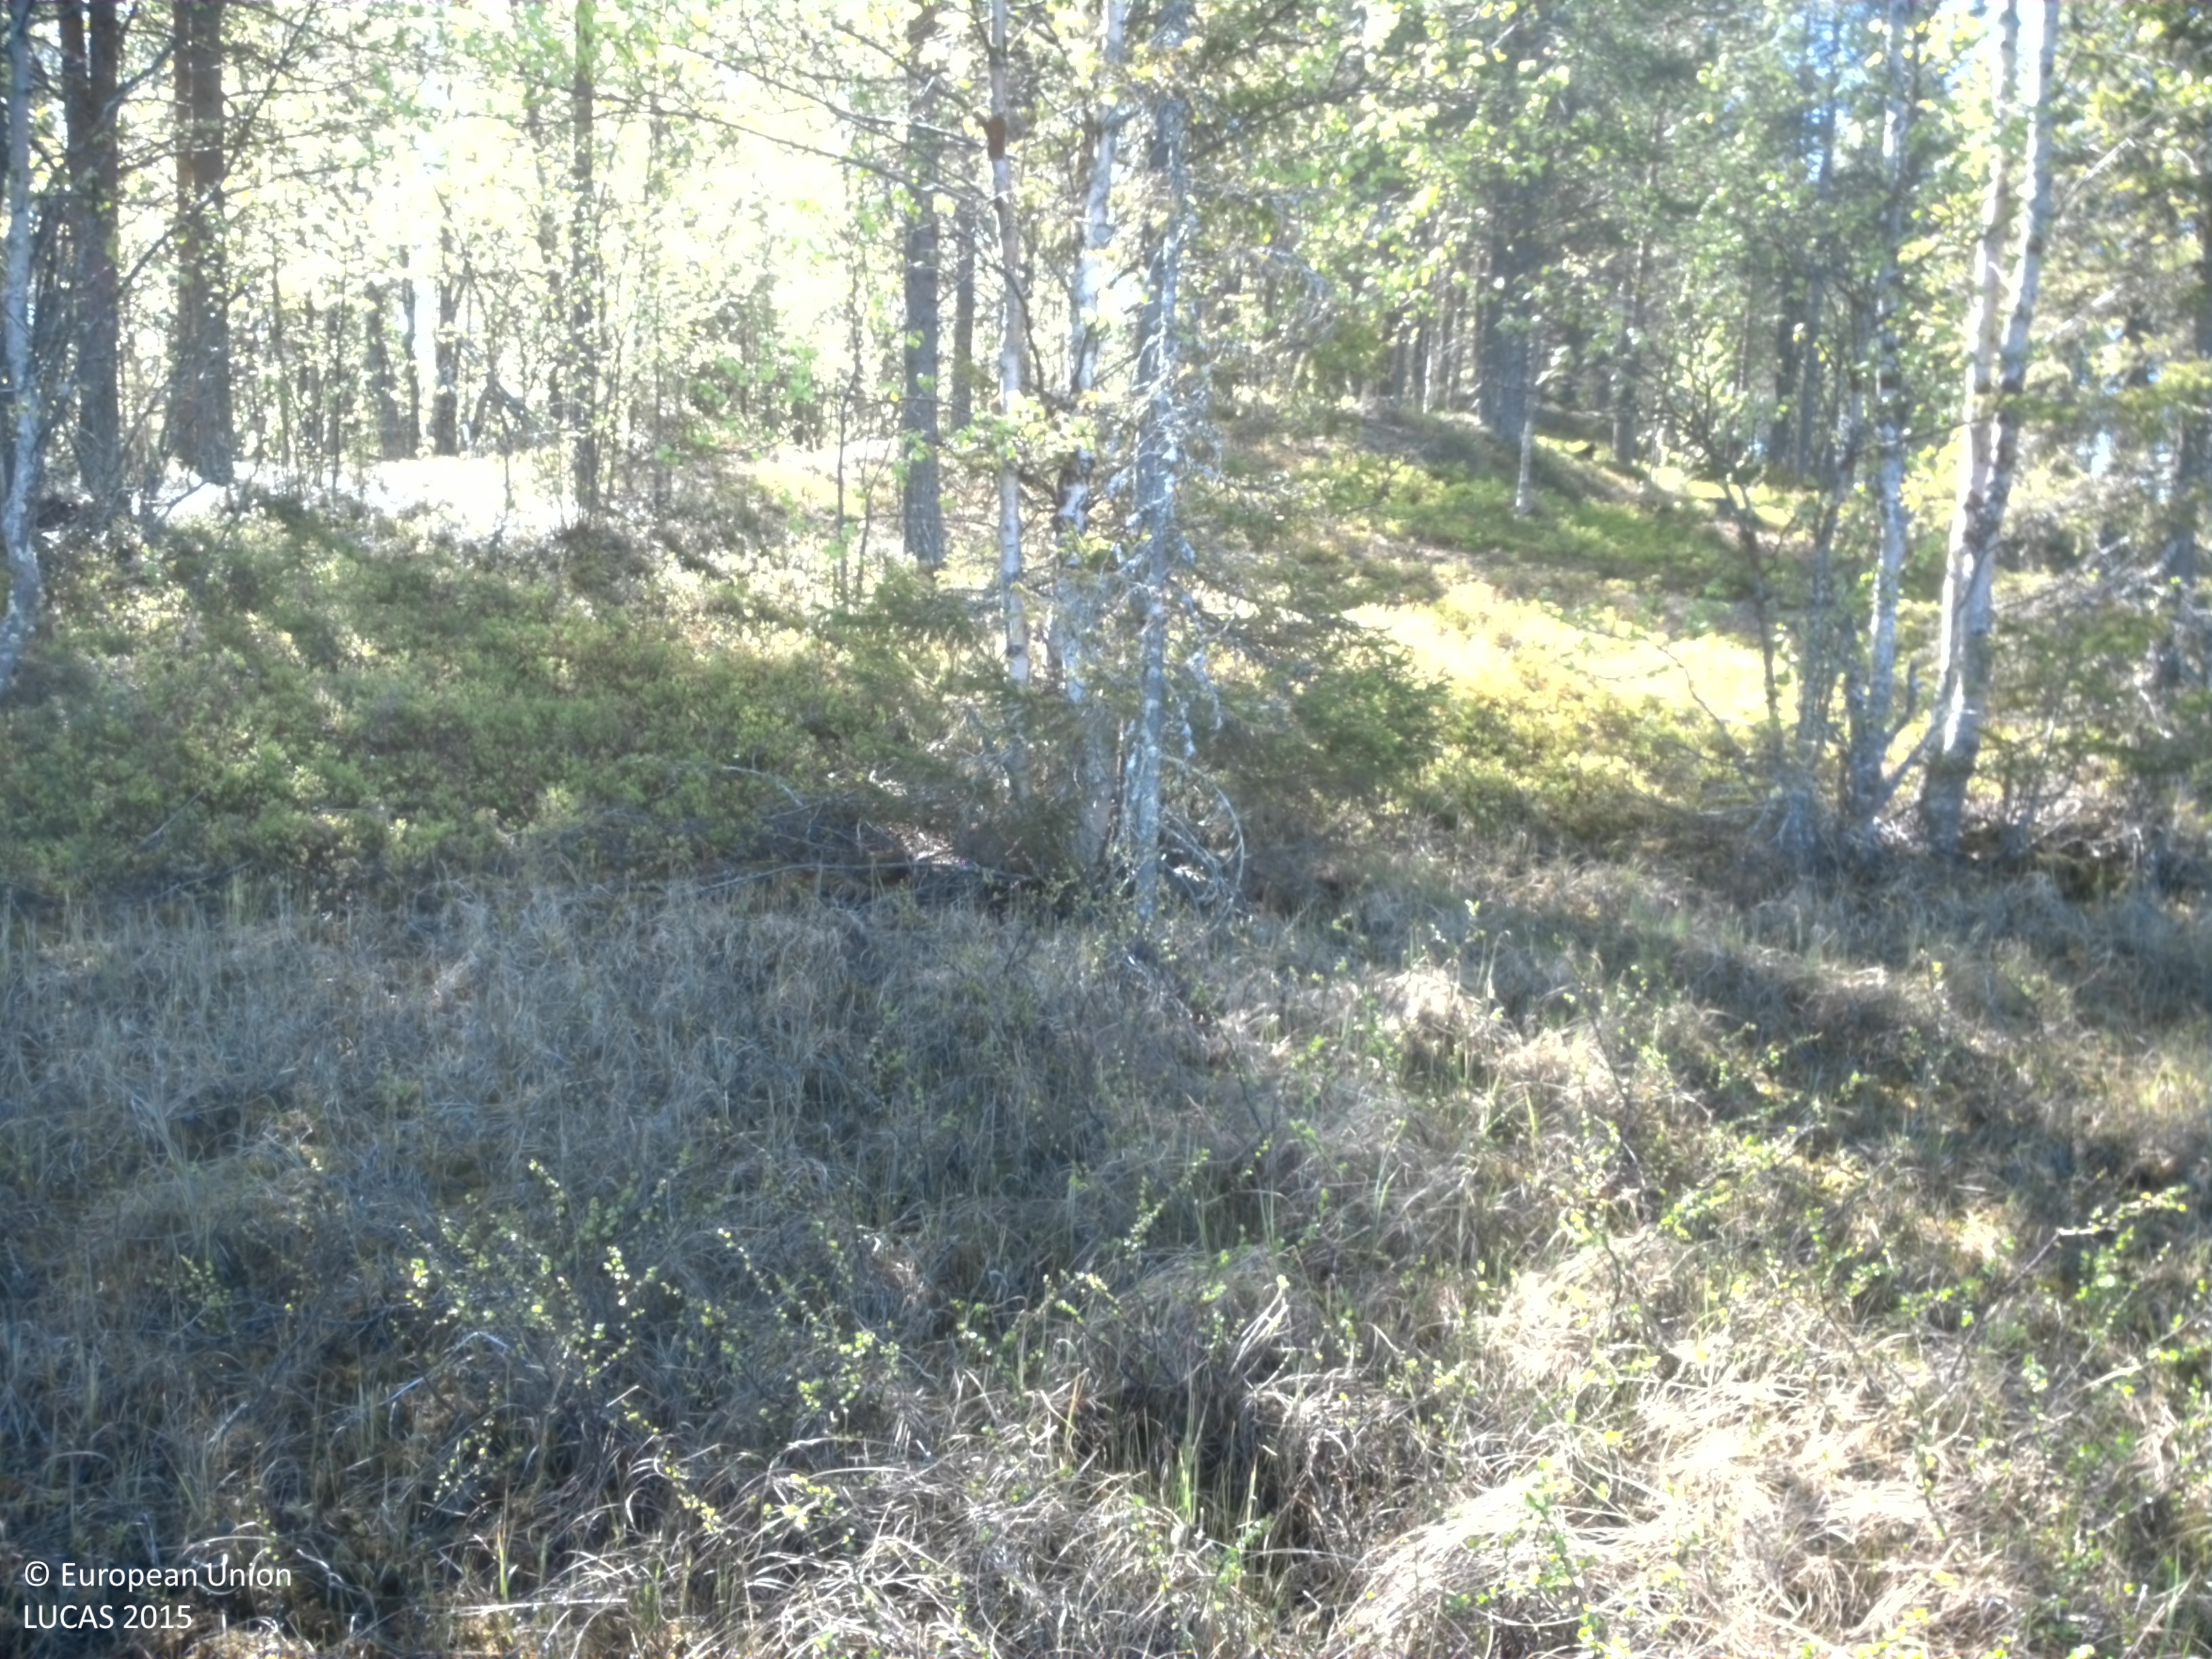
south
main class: Shrubland
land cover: Shrubland with sparse tree cover
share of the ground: 50 - 75 %
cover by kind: shrubs 50 %, herbaceous plants 45 %, broadleaved forest trees 5 %
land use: Semi-natural and natural areas not in use
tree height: < 5 m
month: June
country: SE
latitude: 67.1823
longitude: 21.2519
